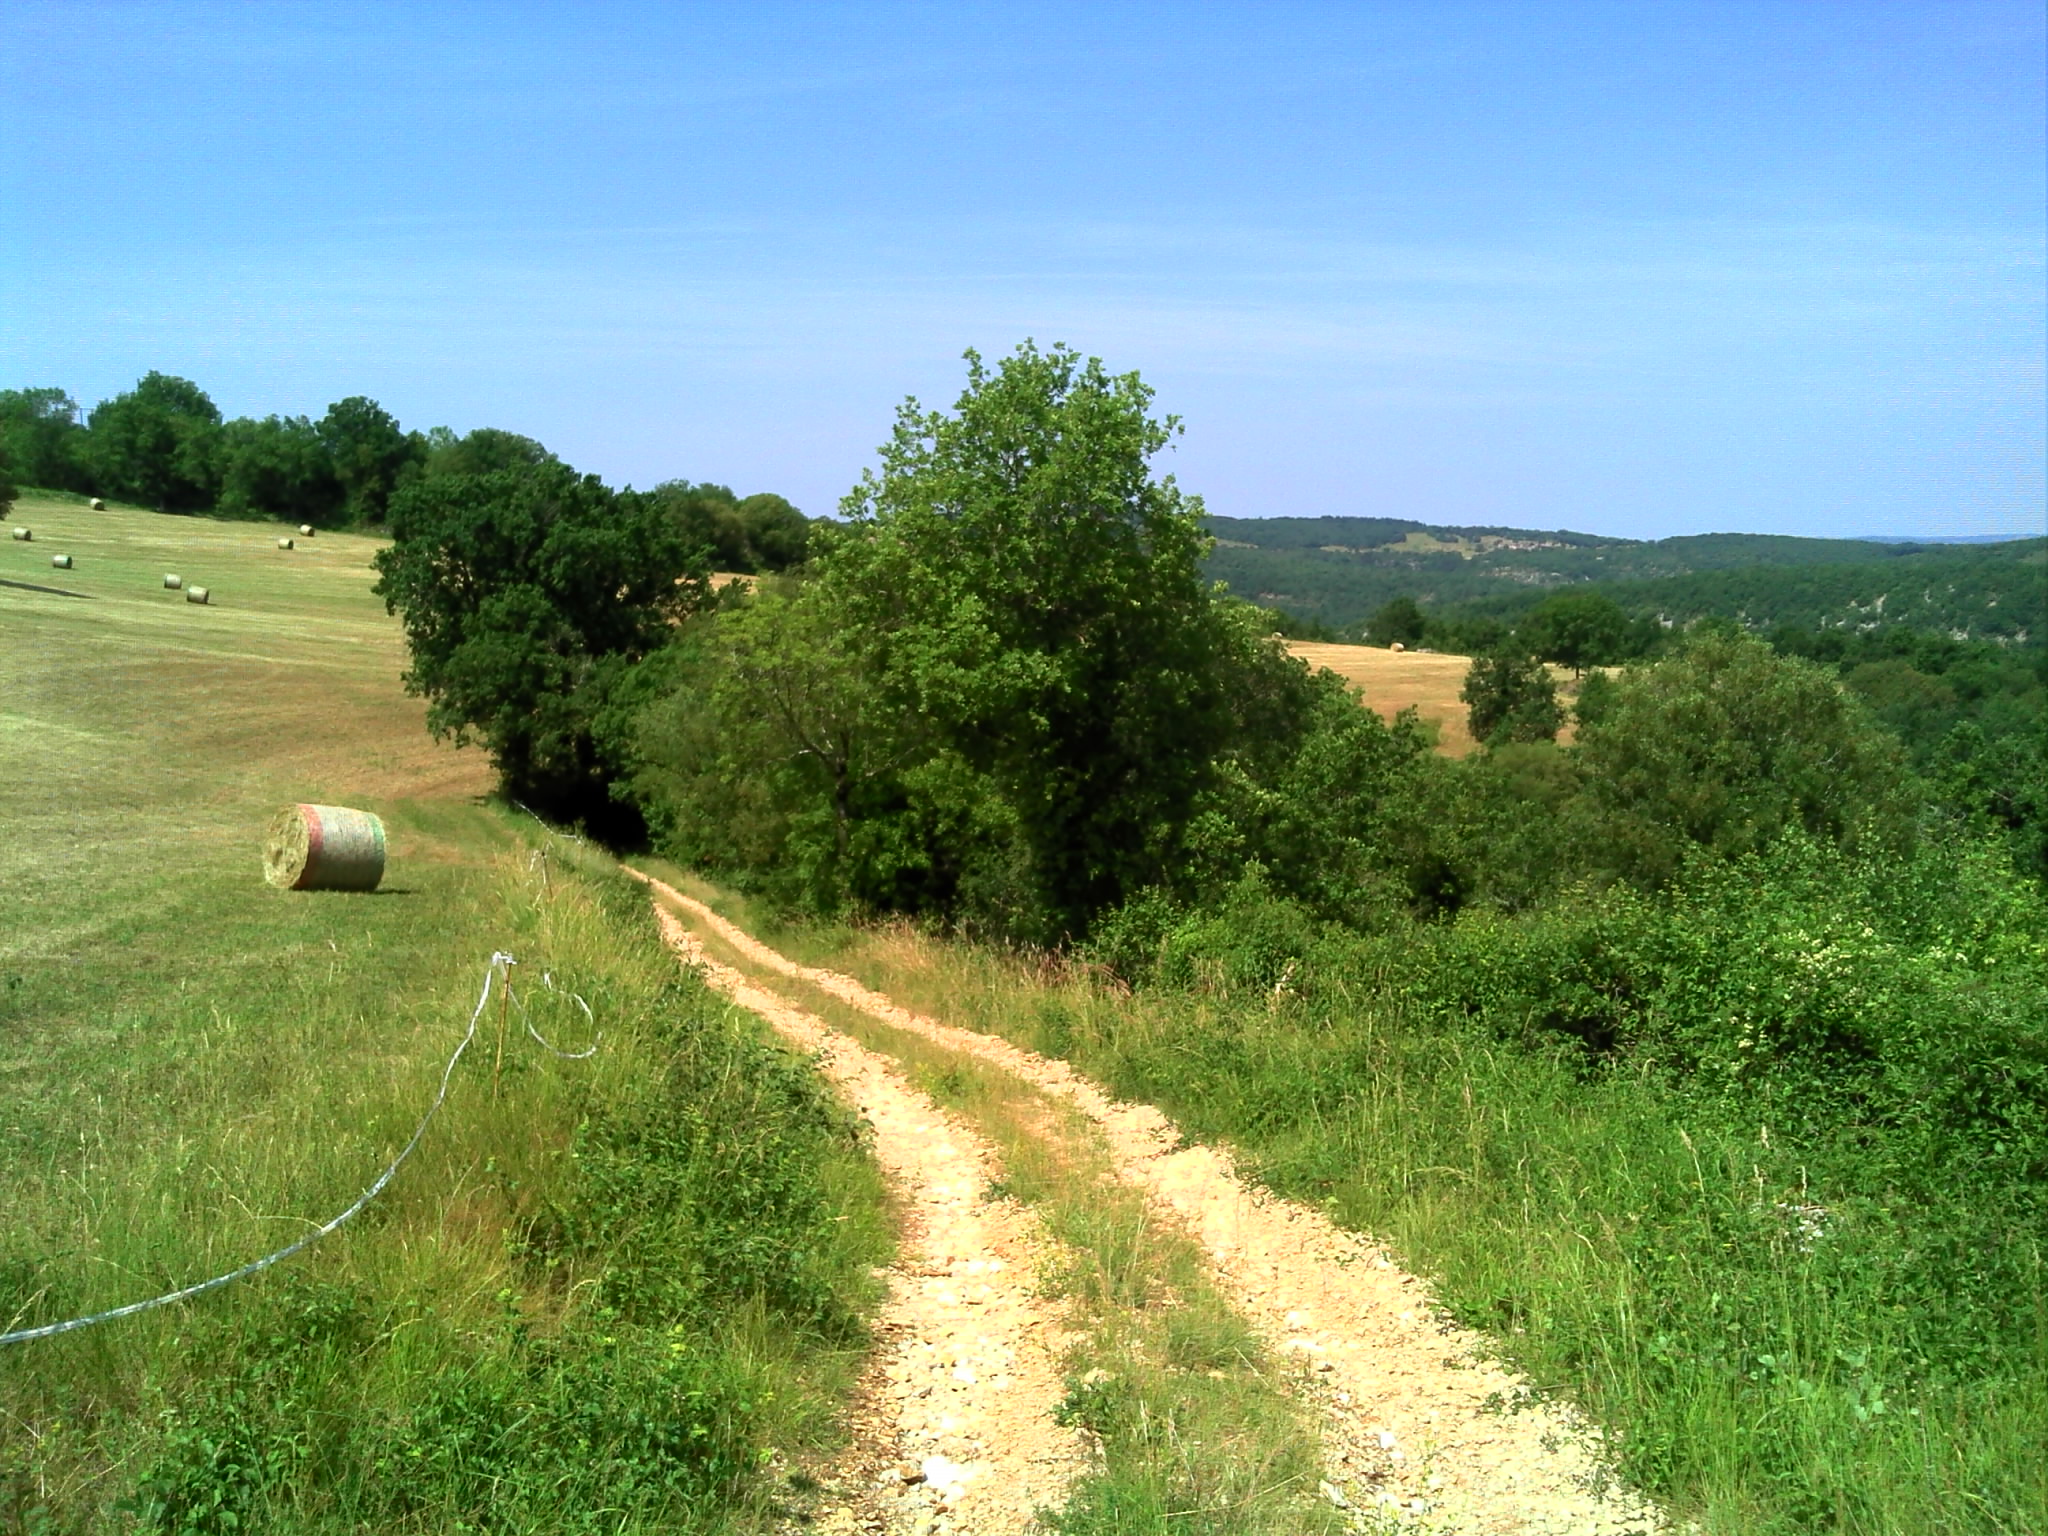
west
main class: Grassland
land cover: Grassland without tree/shrub cover
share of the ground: > 75 %
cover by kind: herbaceous plants 100 %
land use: Agriculture (excluding fallow land and kitchen gardens)
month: June
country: FR
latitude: 44.4977
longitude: 1.8124
